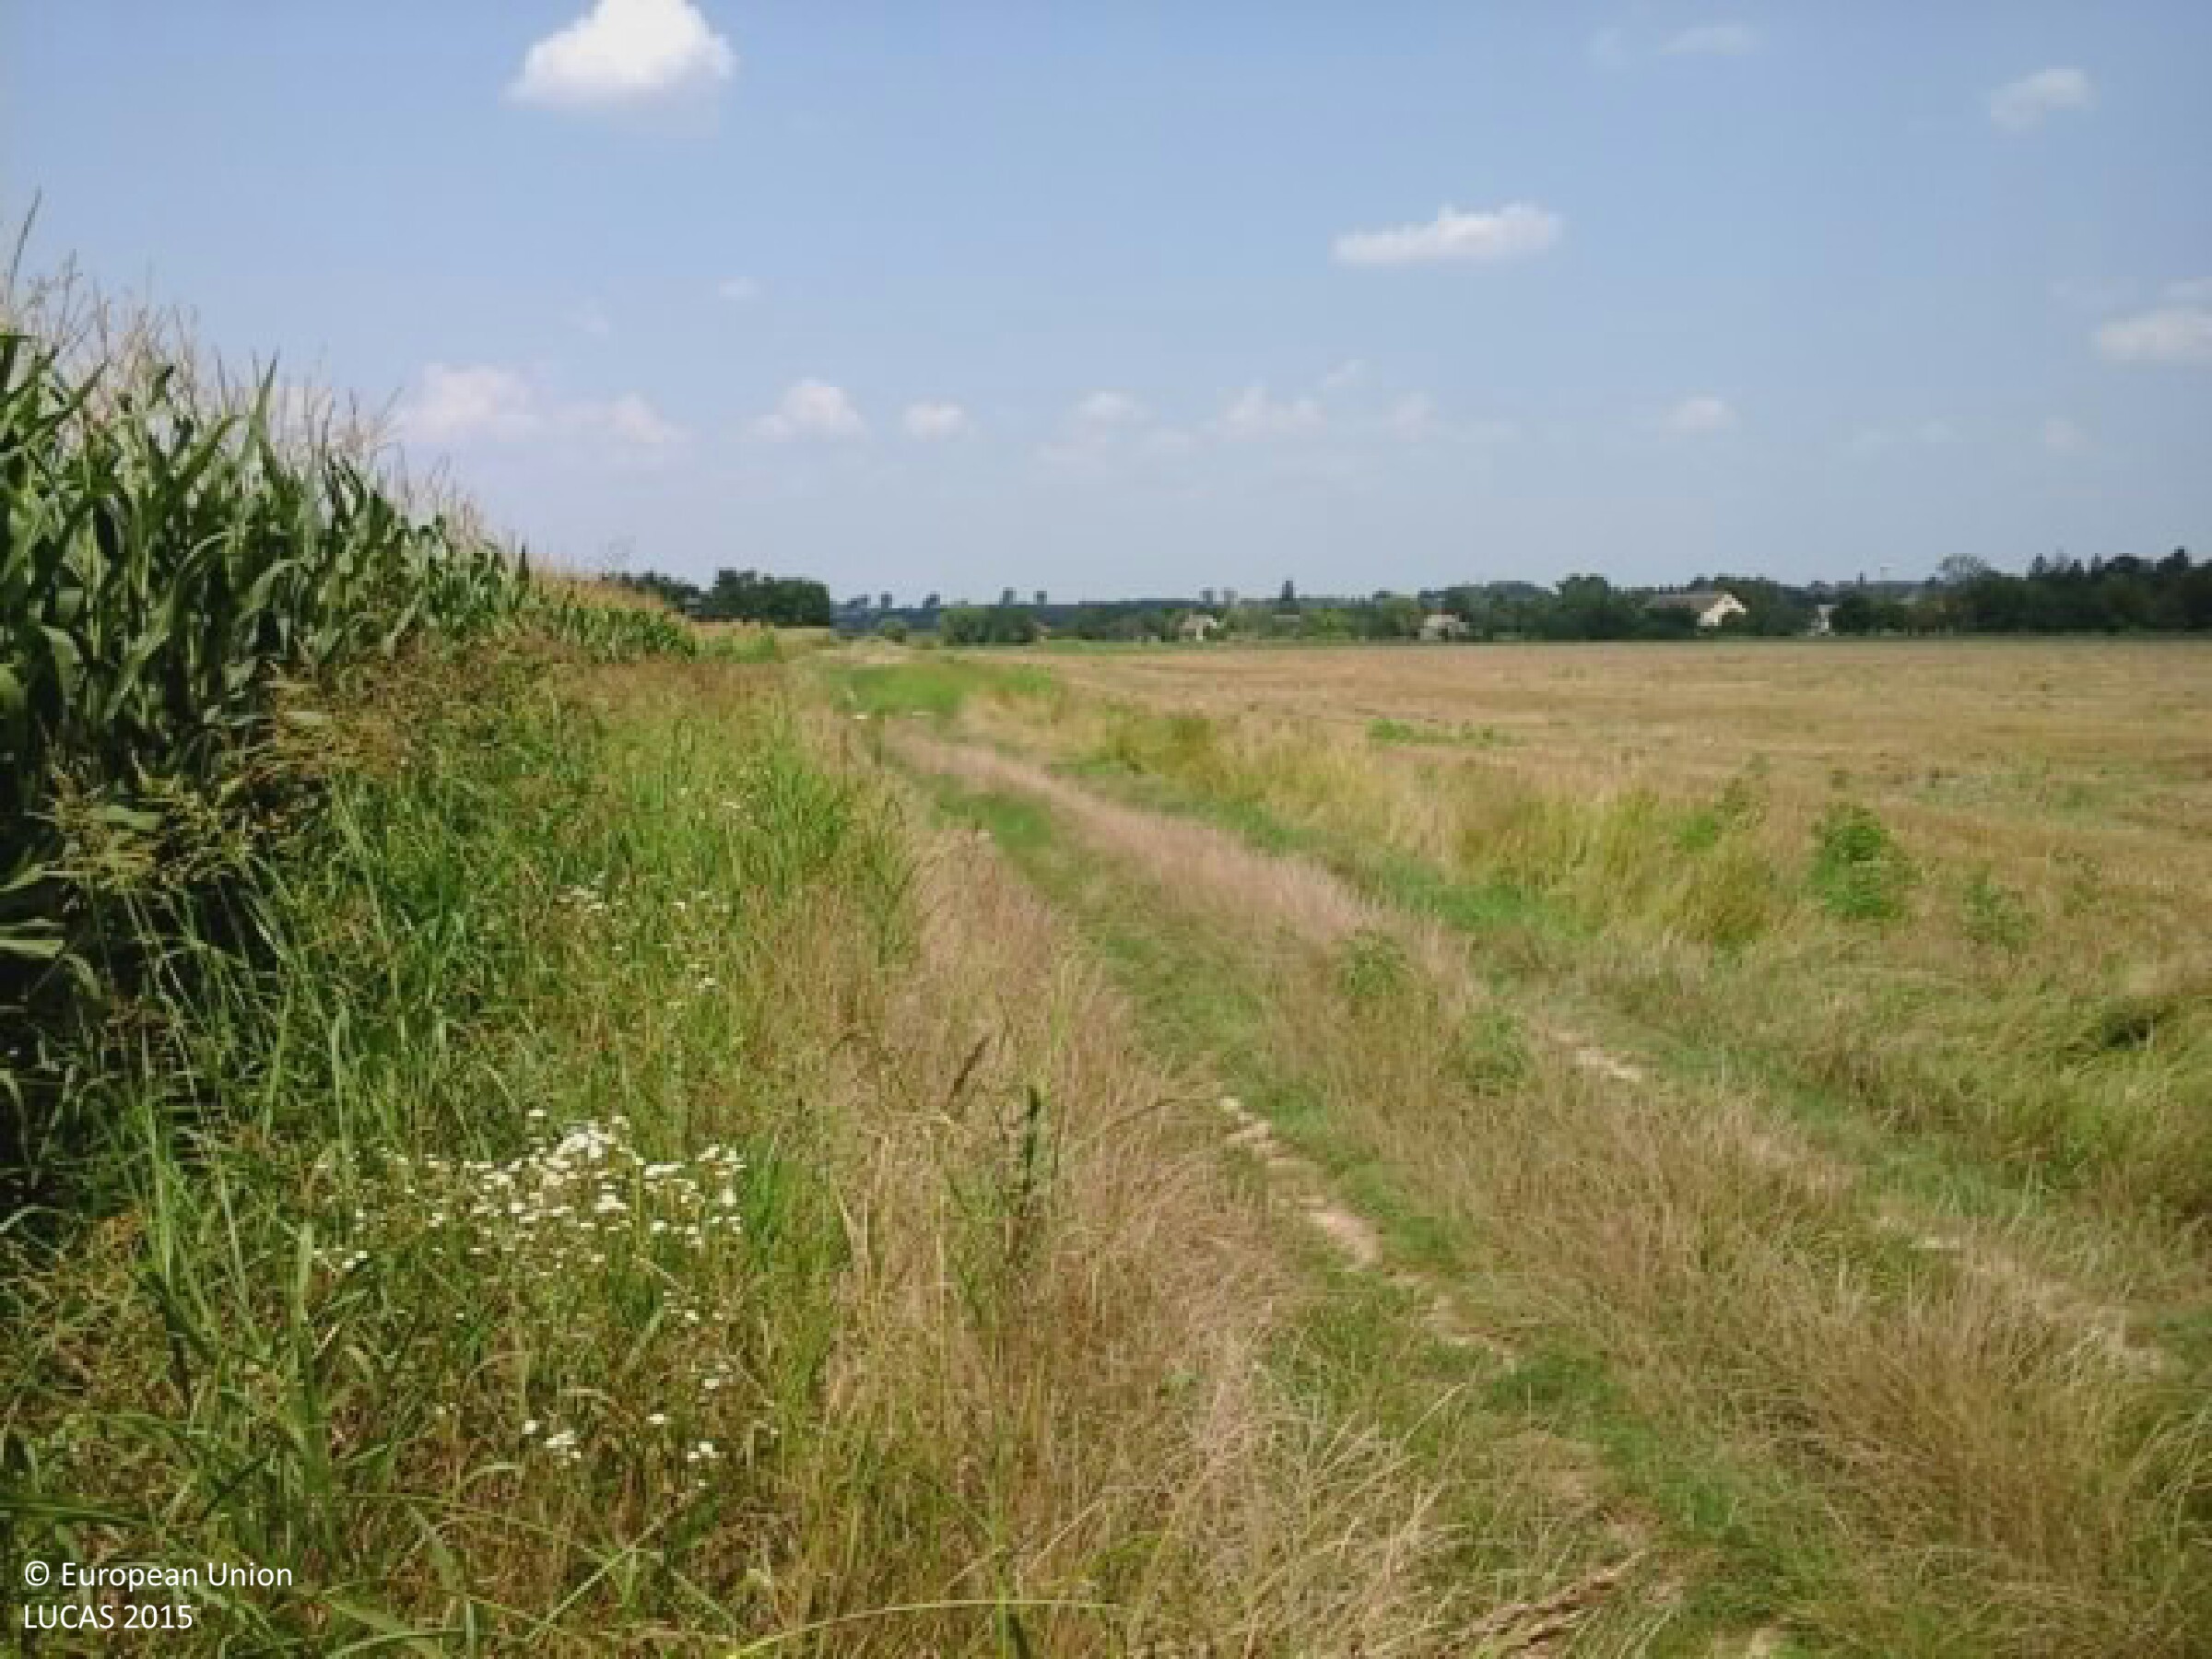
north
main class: Cropland
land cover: Maize
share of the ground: > 75 %
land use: Agriculture (excluding fallow land and kitchen gardens)
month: August
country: HU
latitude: 46.3448
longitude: 17.9455
